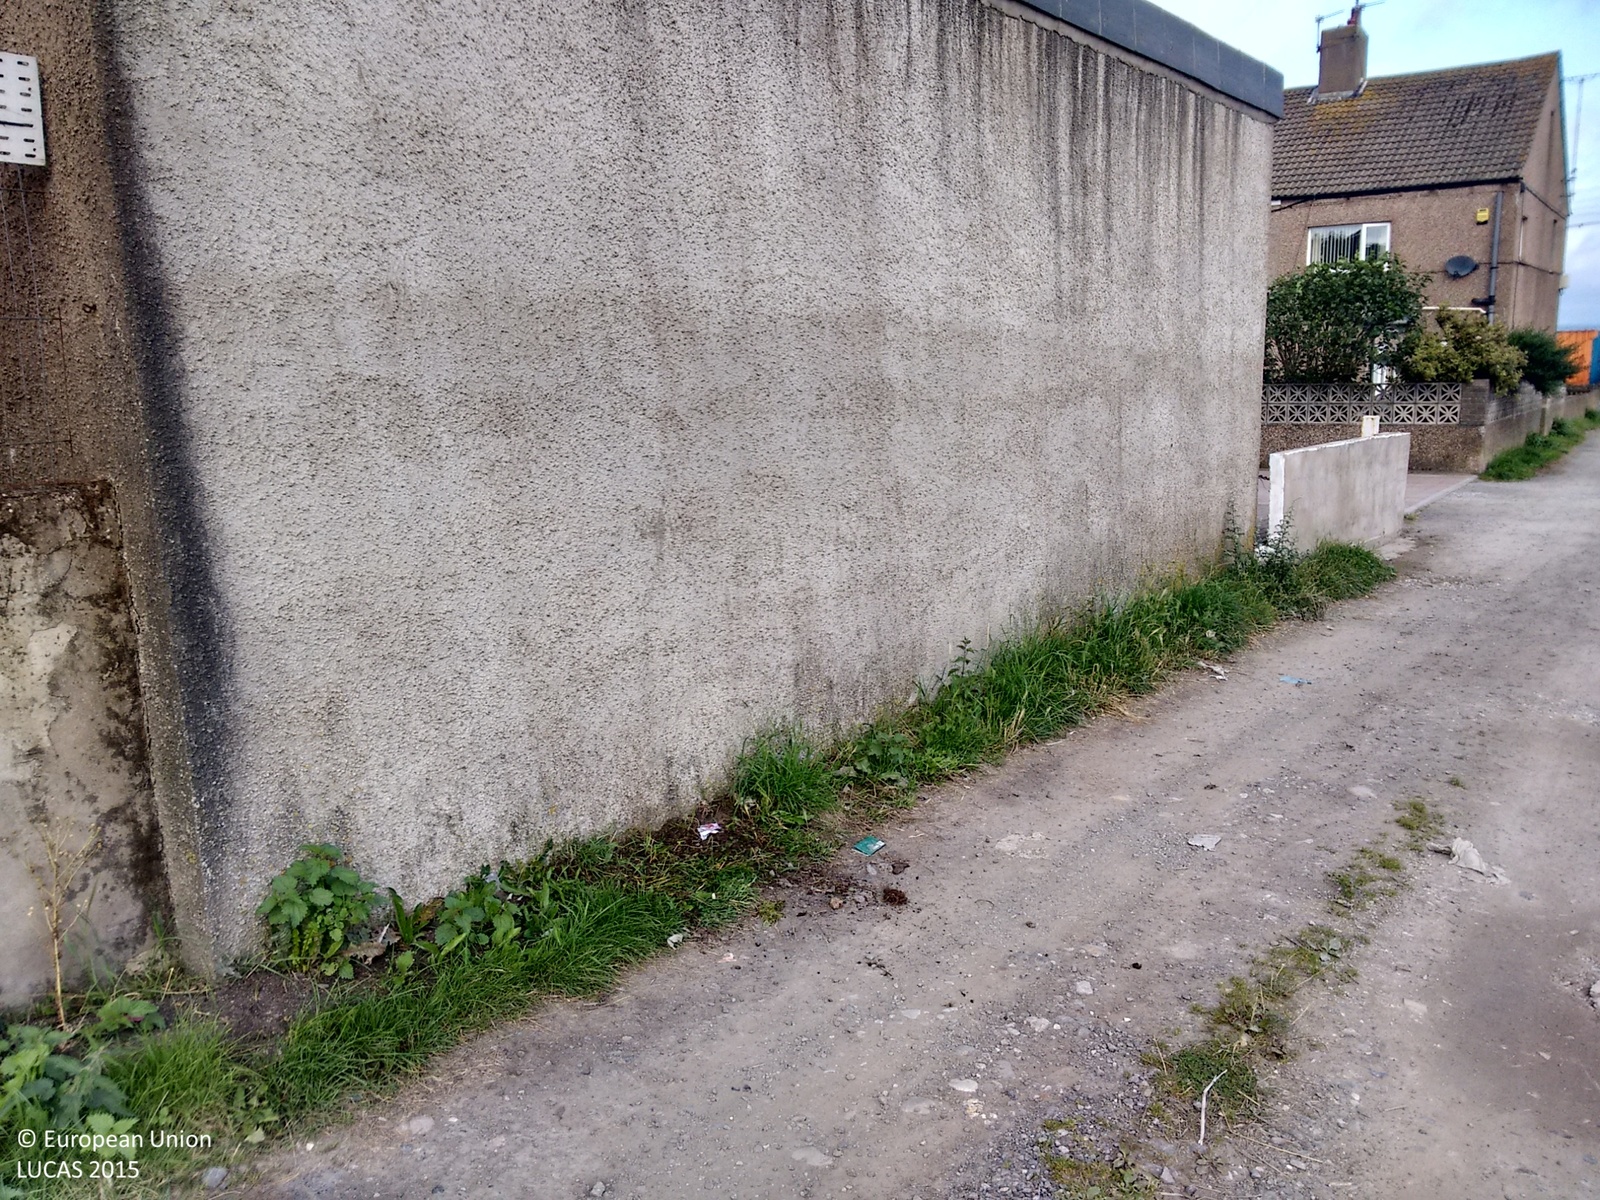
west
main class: Grassland
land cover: Spontaneously vegetated surfaces
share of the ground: > 75 %
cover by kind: herbaceous plants 100 %
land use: Fallow land
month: August
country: GB
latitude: 54.6817
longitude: -3.5295
